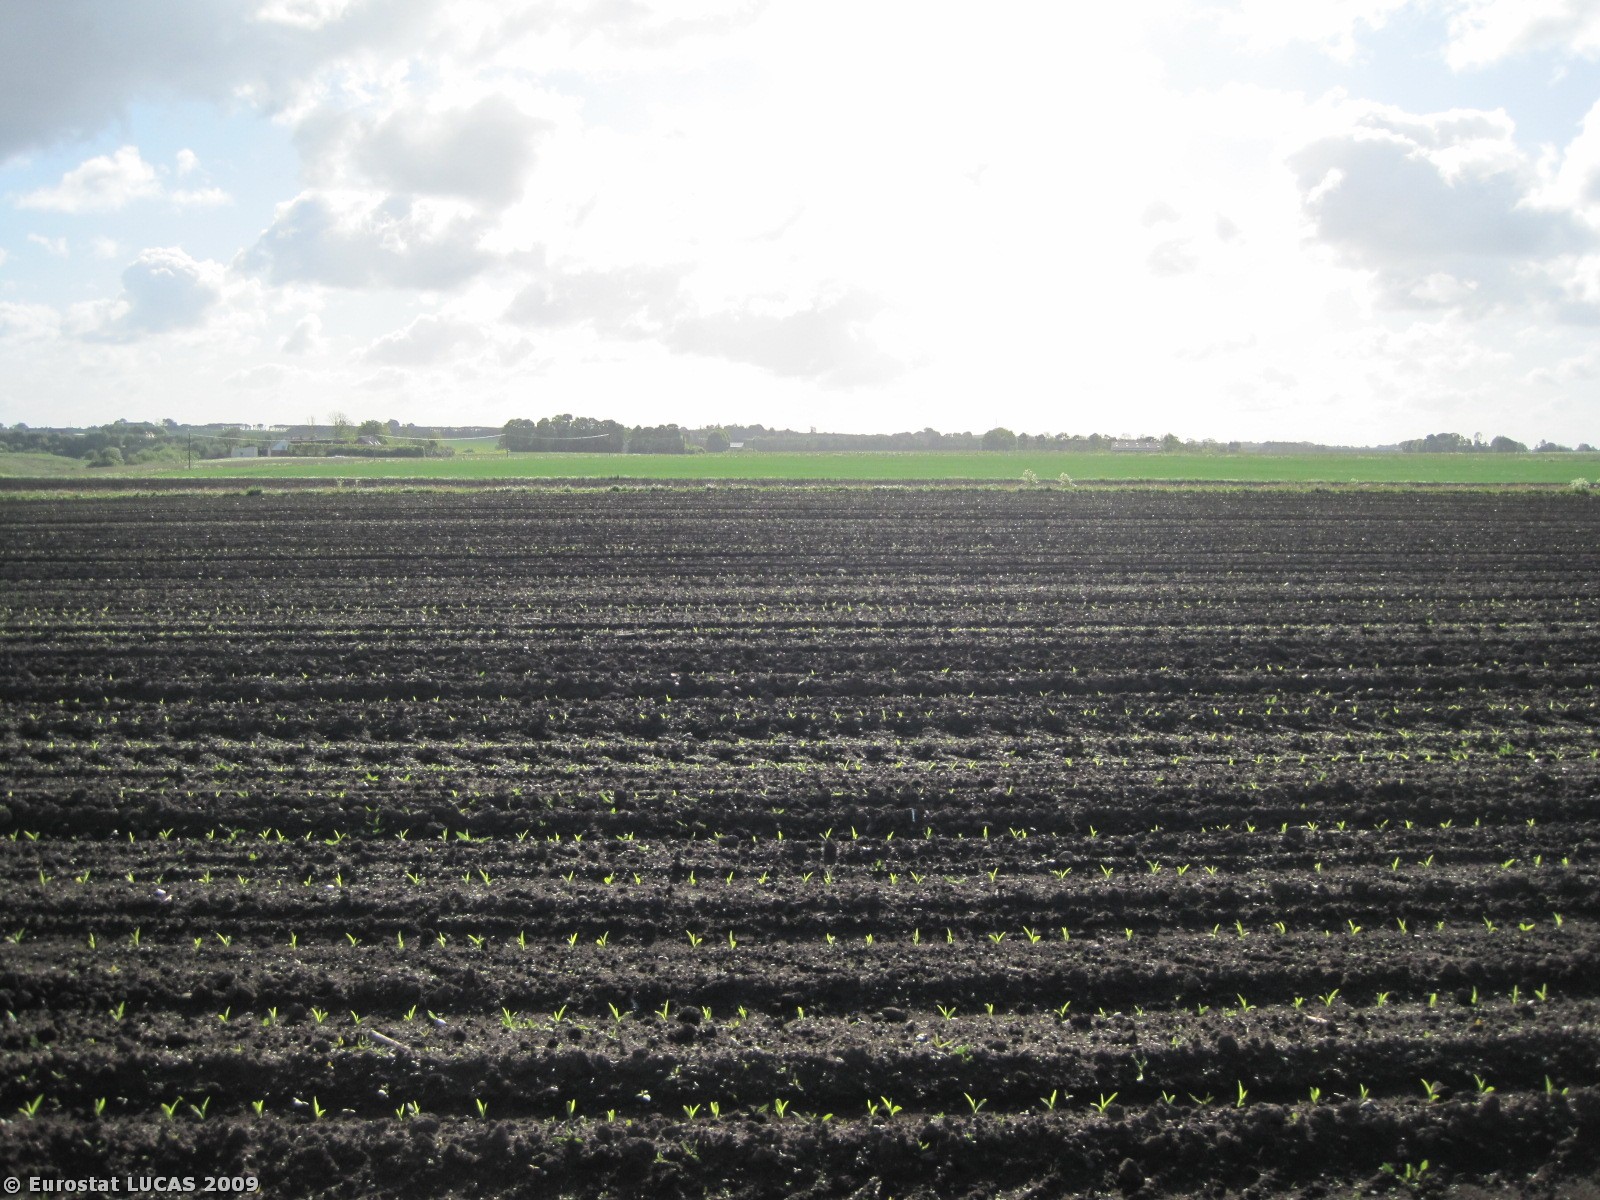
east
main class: Cropland
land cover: Maize
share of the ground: < 10 %
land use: Agriculture (excluding fallow land and kitchen gardens)
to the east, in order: Maize; Grass margins; Tracks; Grass margins; Maize; Grass margins; Tracks; Grass margins; Common wheat
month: May
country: DK
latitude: 56.5109
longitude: 9.6917
